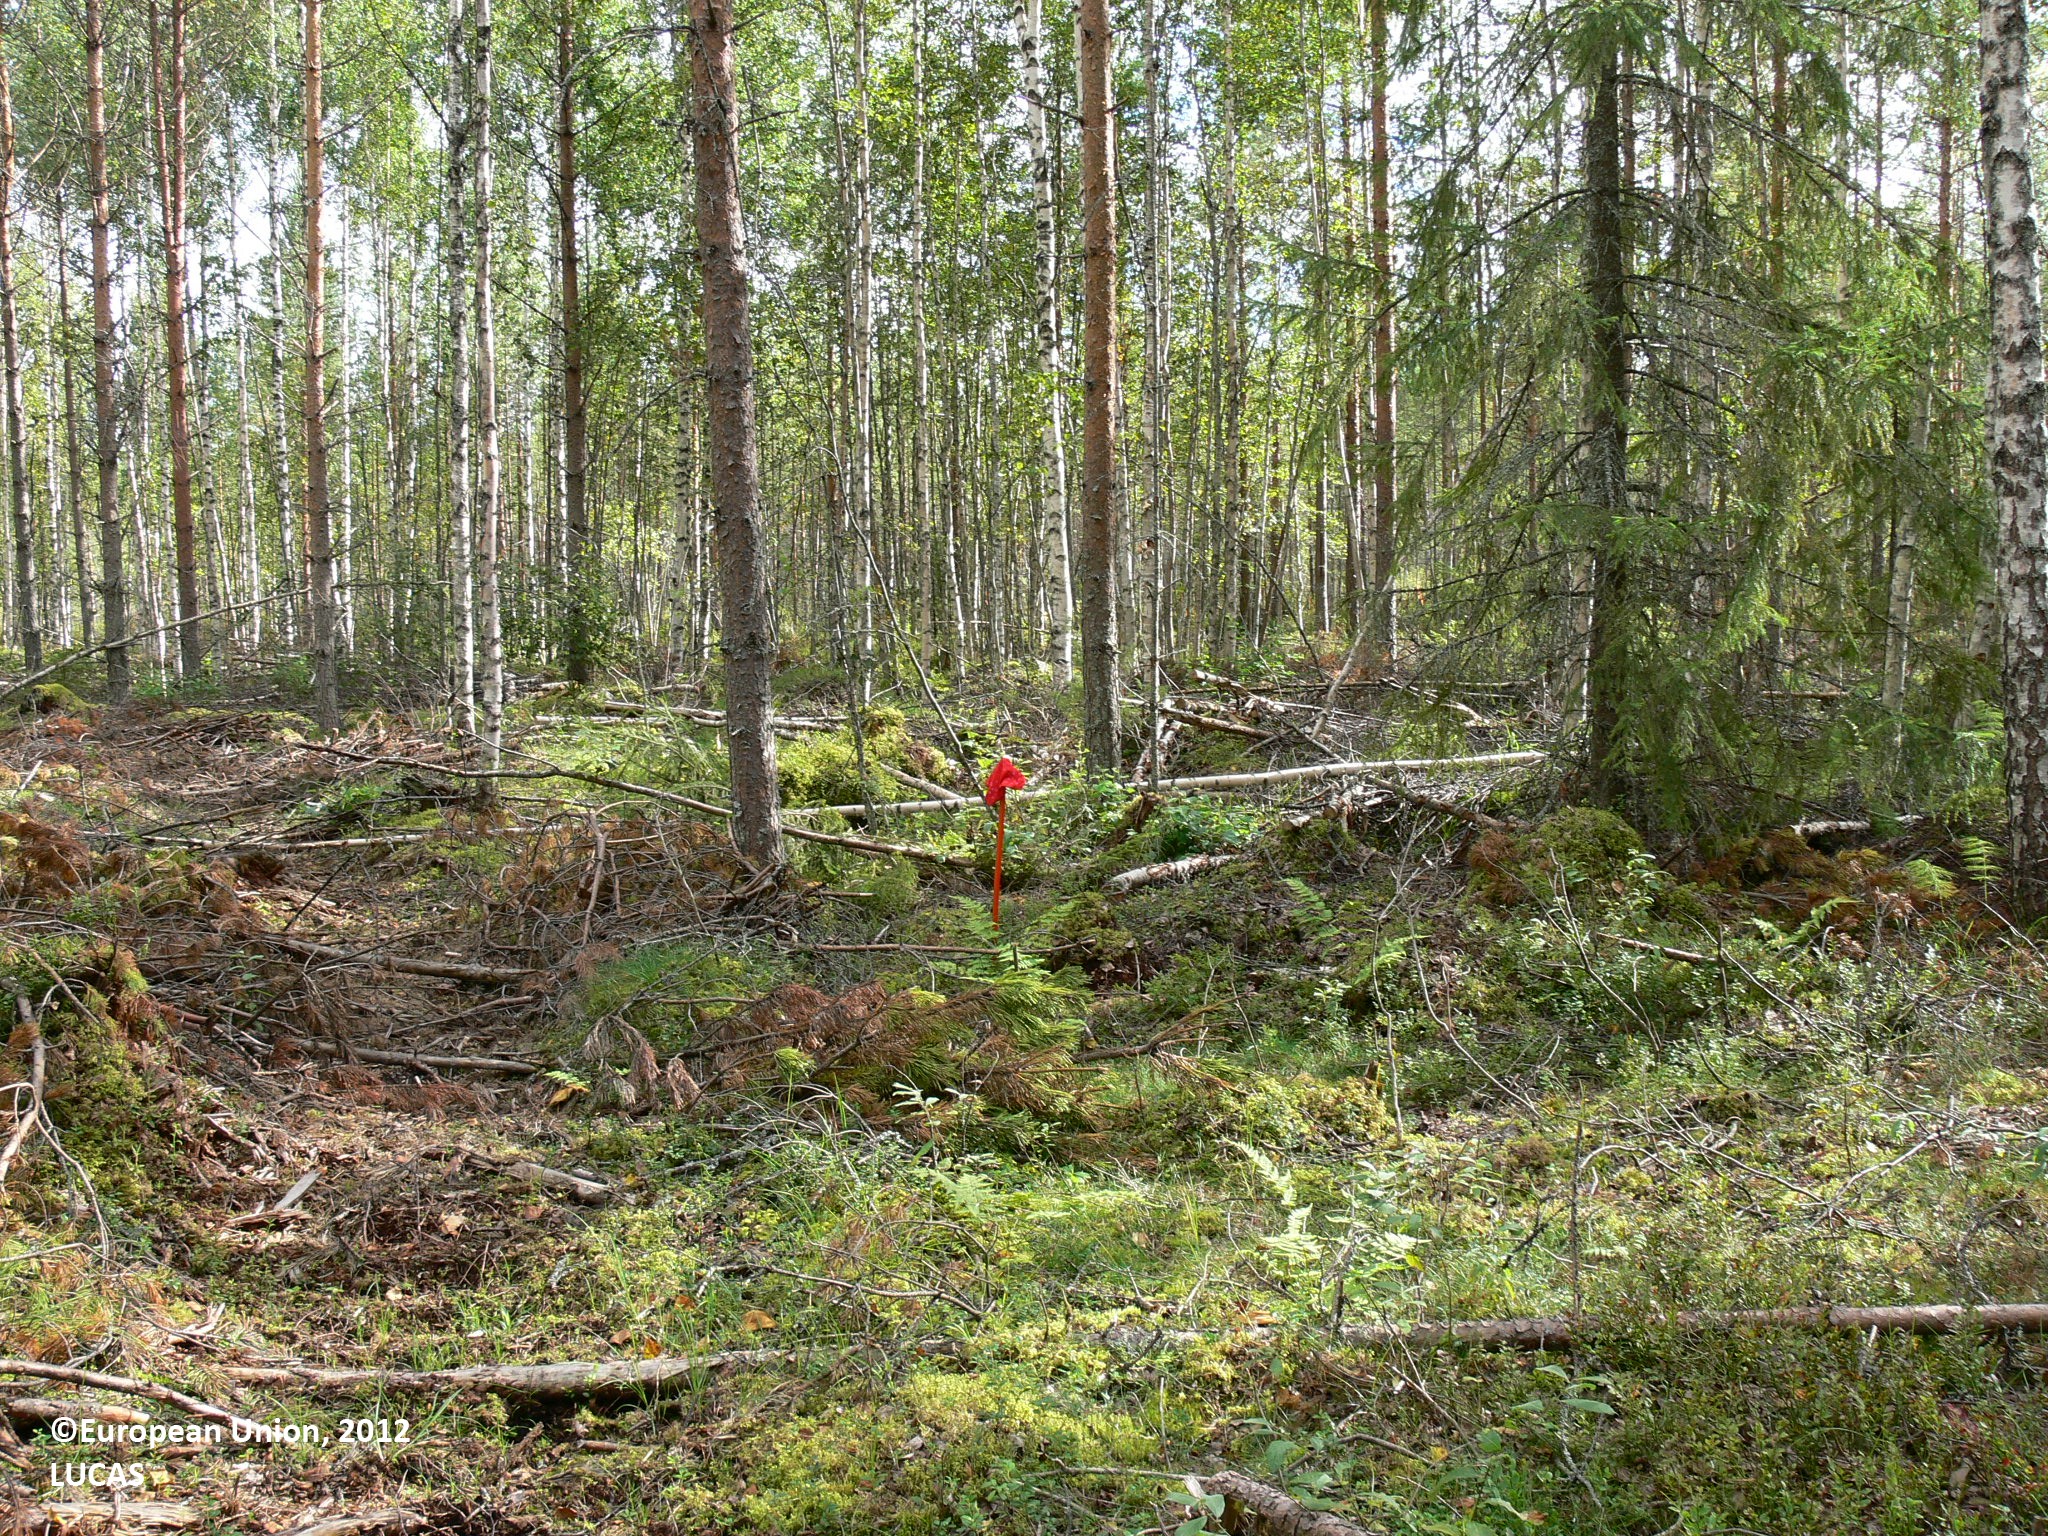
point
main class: Woodland
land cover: Pine dominated mixed woodland
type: boreal forest
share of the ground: 50 - 75 %
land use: Forestry
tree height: > 5 m
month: August
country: FI
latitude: 63.3255
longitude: 30.2888
